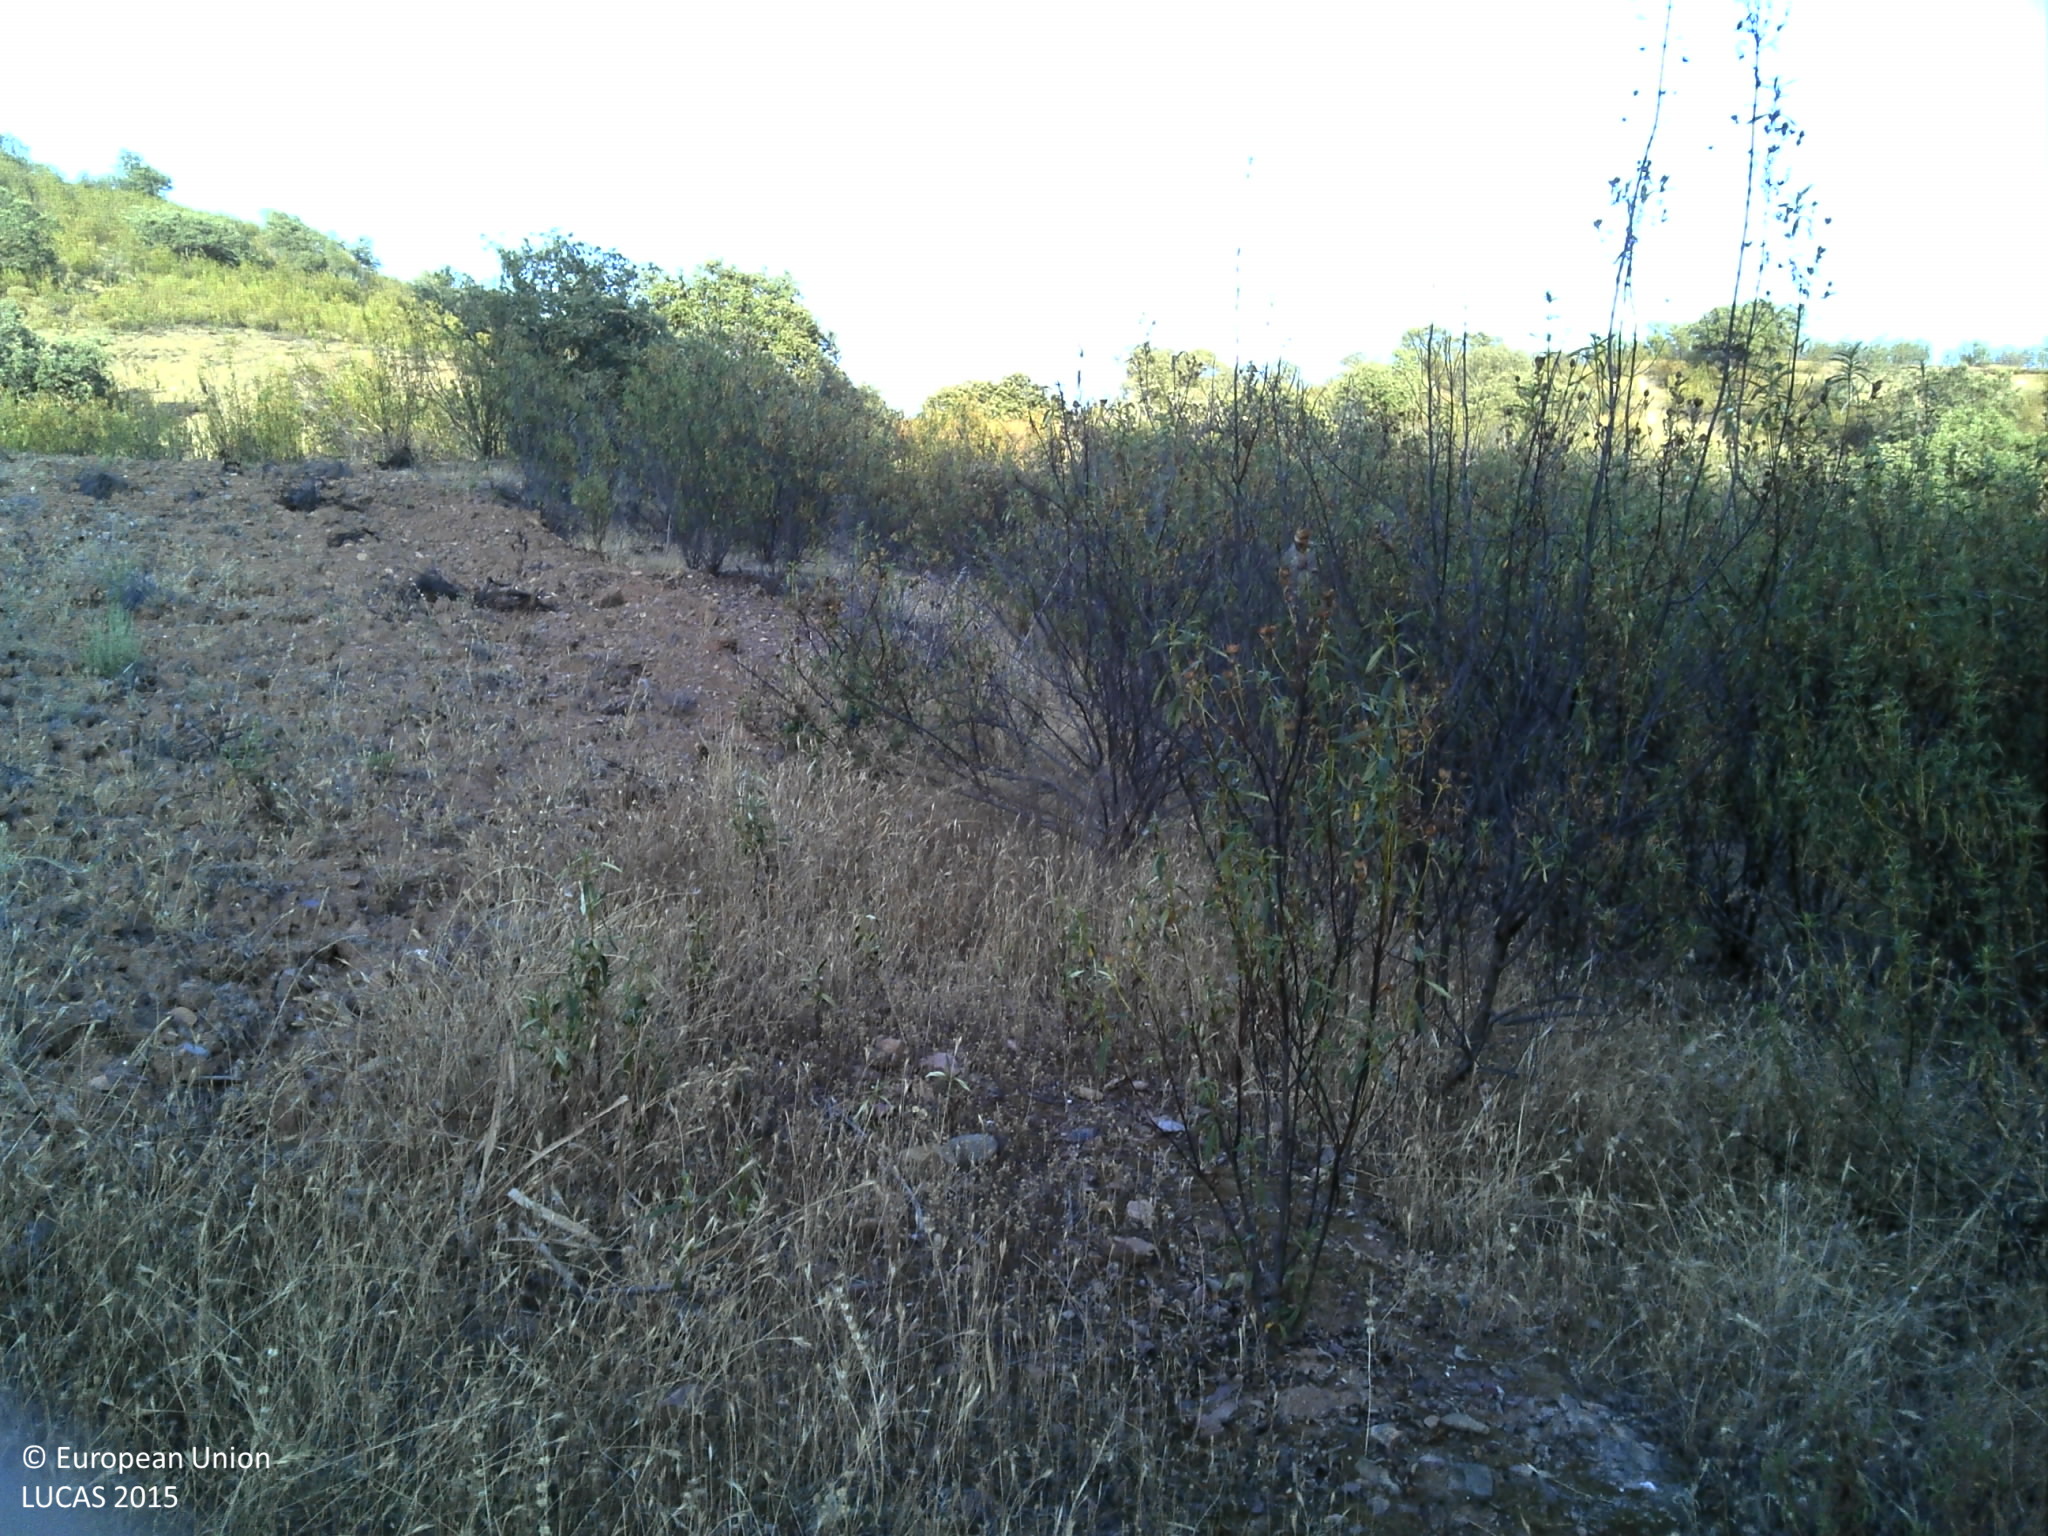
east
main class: Woodland
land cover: Broadleaved woodland
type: broadleaved evergreen forest
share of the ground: 10 - 25 %
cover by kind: shrubs 45 %, herbaceous plants 35 %, broadleaved forest trees 20 %
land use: Agriculture (excluding fallow land and kitchen gardens)
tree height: > 5 m
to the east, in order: Broadleaved woodland; Rivers and streams; Broadleaved woodland; Other bare soil; Shrubland without tree cover; Broadleaved woodland; Shrubland without tree cover; Rivers and streams; Shrubland with sparse tree cover
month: June
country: PT
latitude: 37.5808
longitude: -7.5525
